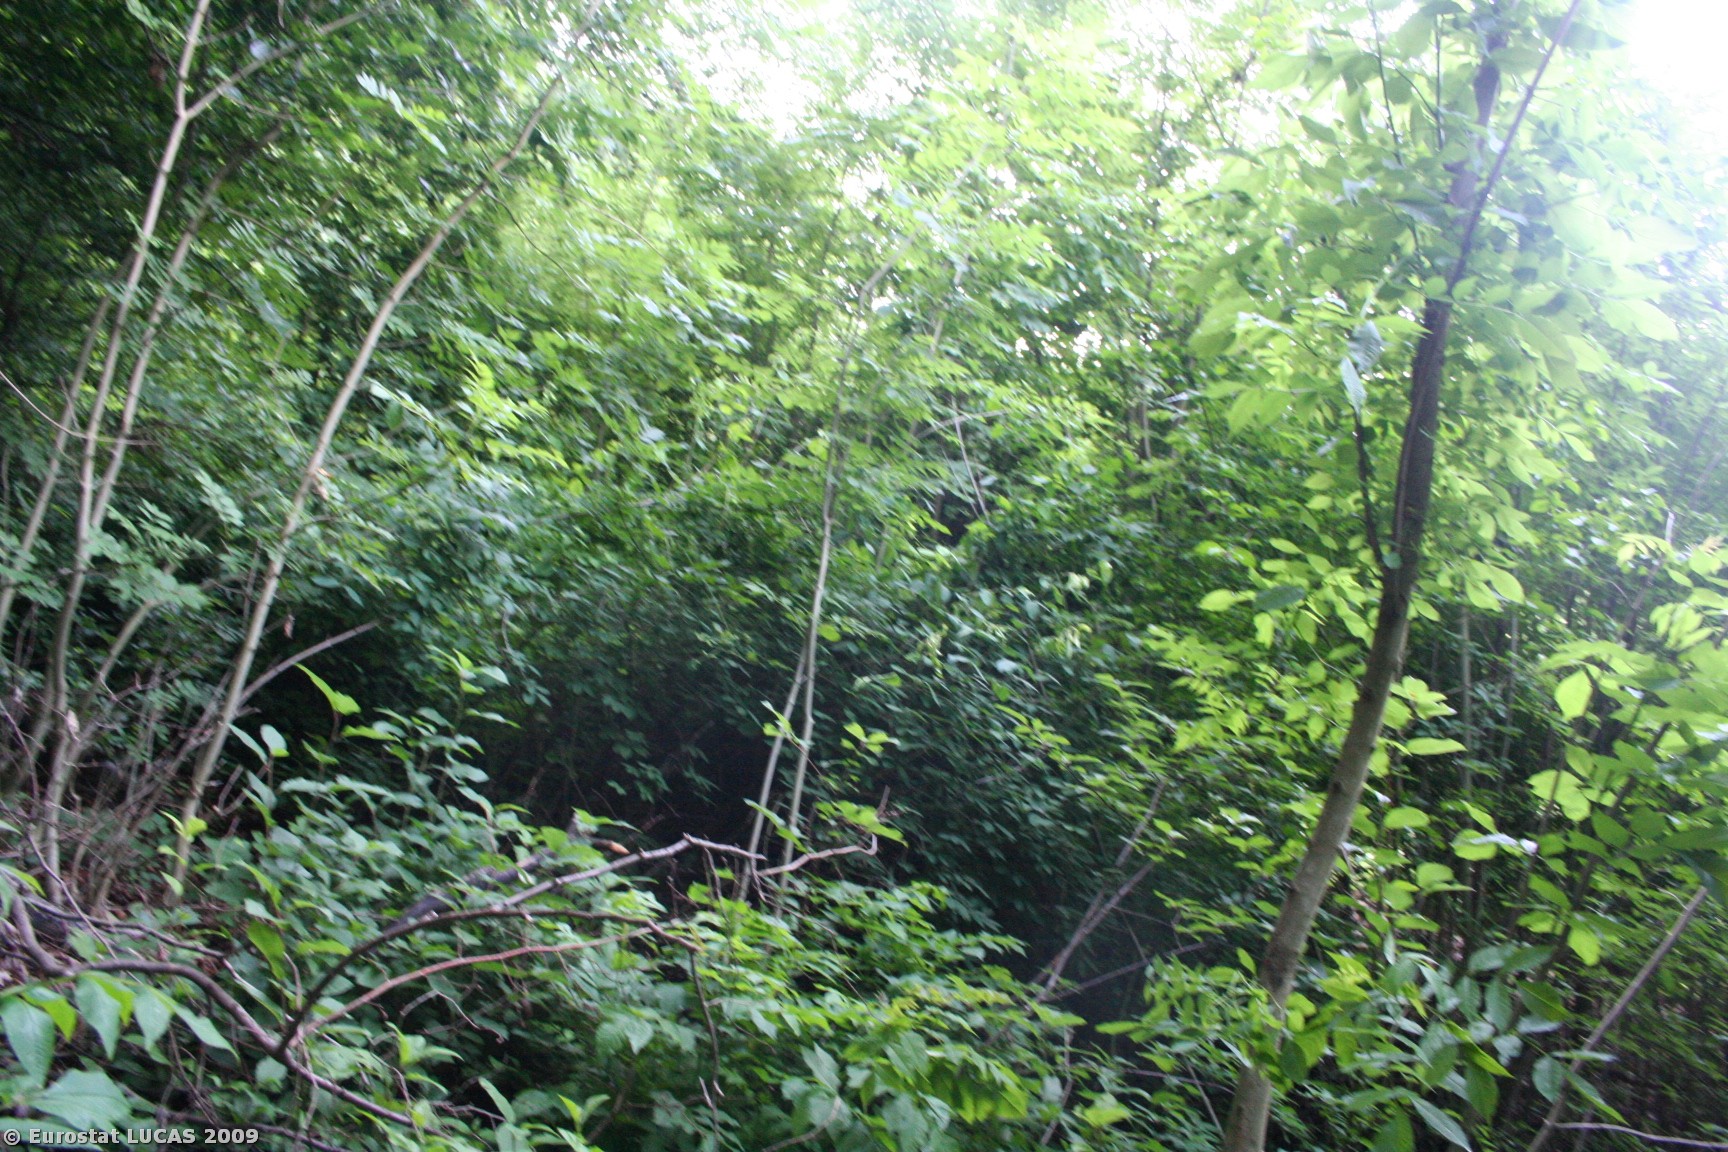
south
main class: Woodland
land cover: Broadleaved woodland
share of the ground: > 75 %
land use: Forestry
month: June
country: AT
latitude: 47.4748
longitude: 13.1961
